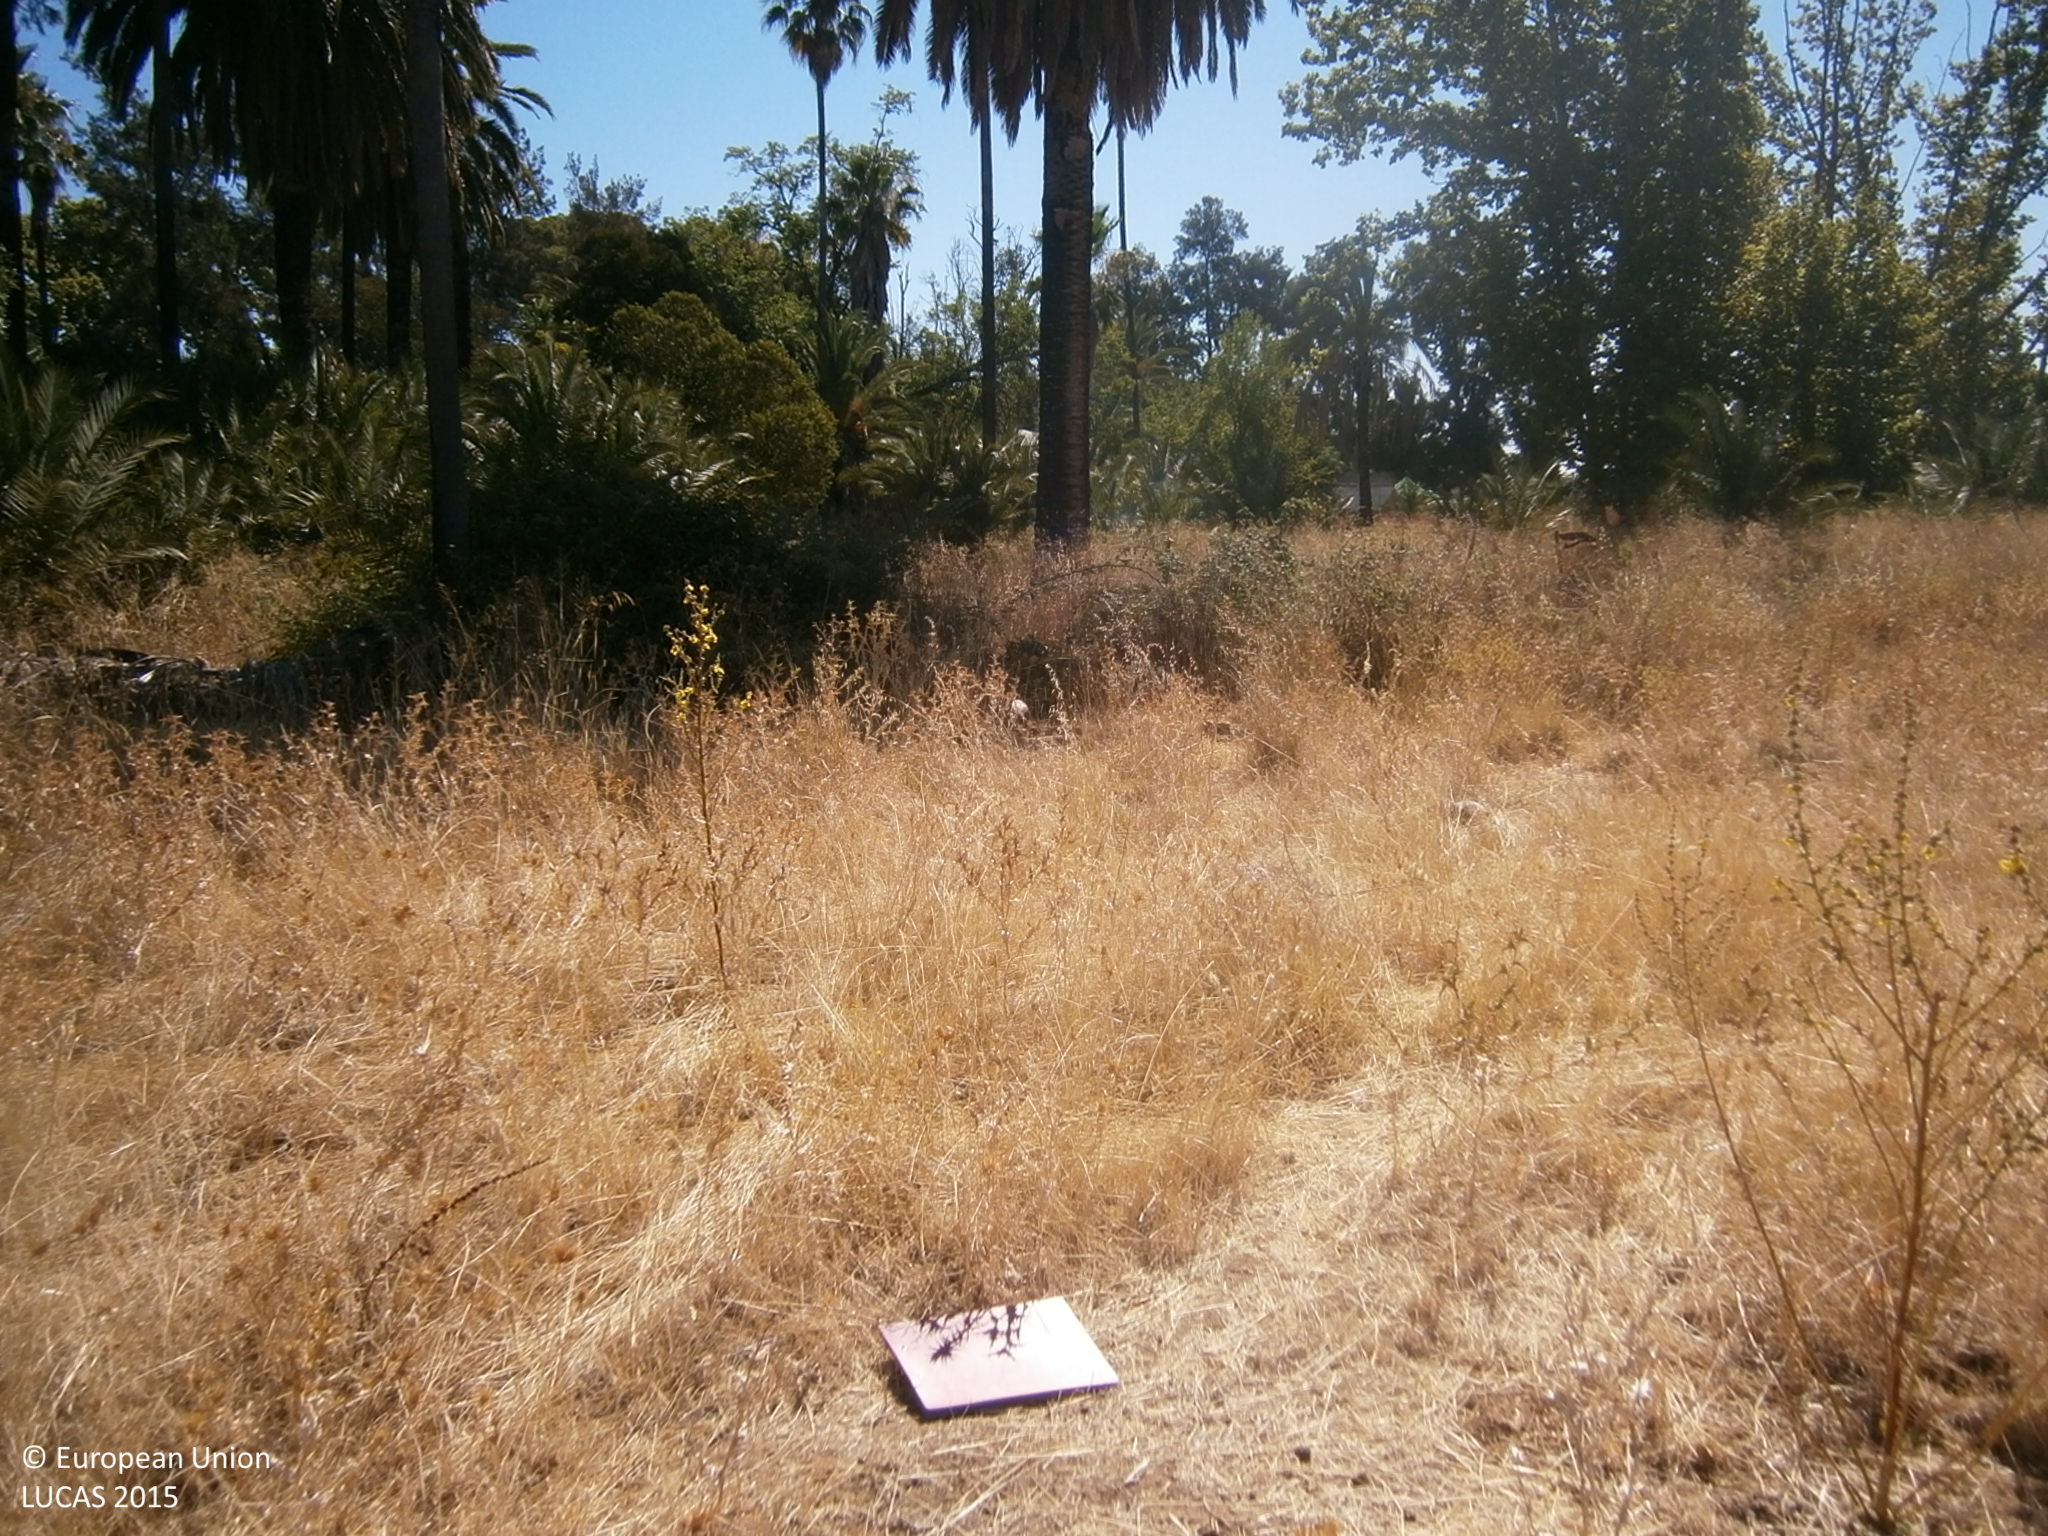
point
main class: Grassland
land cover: Grassland with sparse tree/shrub cover
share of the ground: > 75 %
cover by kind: herbaceous plants 90 %, coniferous forest trees 5 %, shrubs 5 %
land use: Agriculture (excluding fallow land and kitchen gardens)
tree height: > 5 m
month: July
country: ES
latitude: 38.8813
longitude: -7.0044
